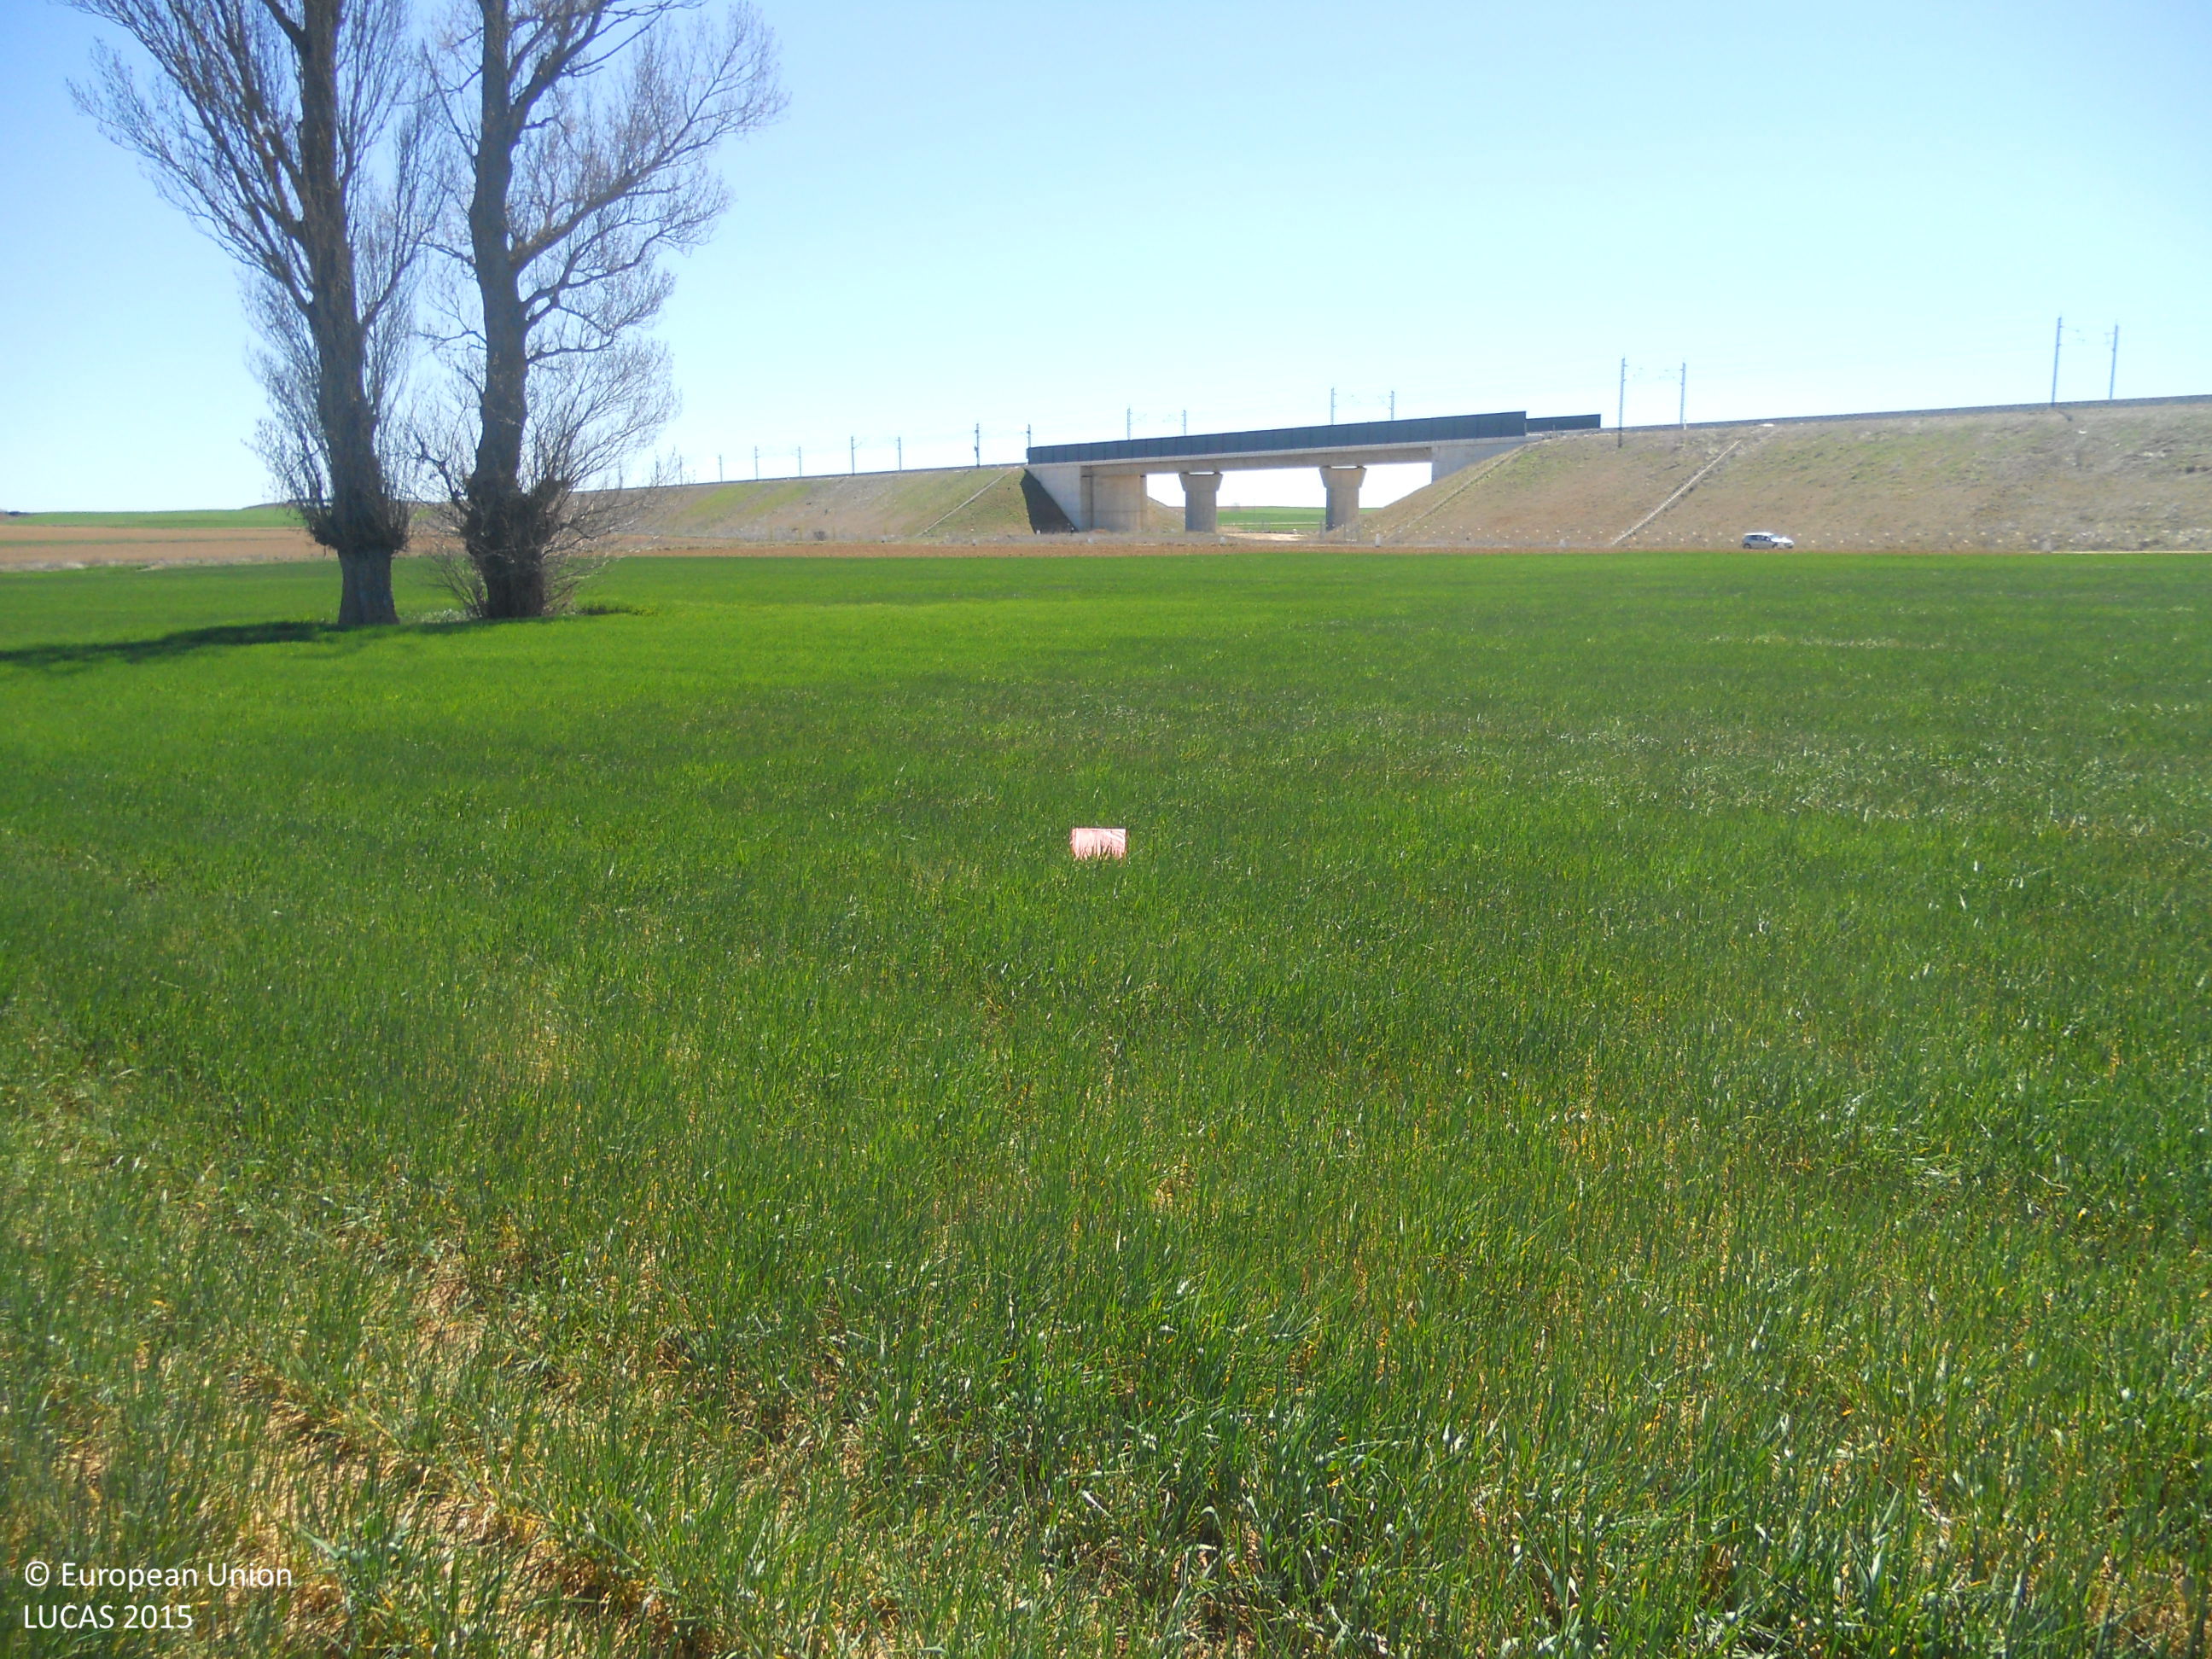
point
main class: Cropland
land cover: Barley
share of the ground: > 75 %
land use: Agriculture (excluding fallow land and kitchen gardens)
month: April
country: ES
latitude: 42.2308
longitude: -4.8487
